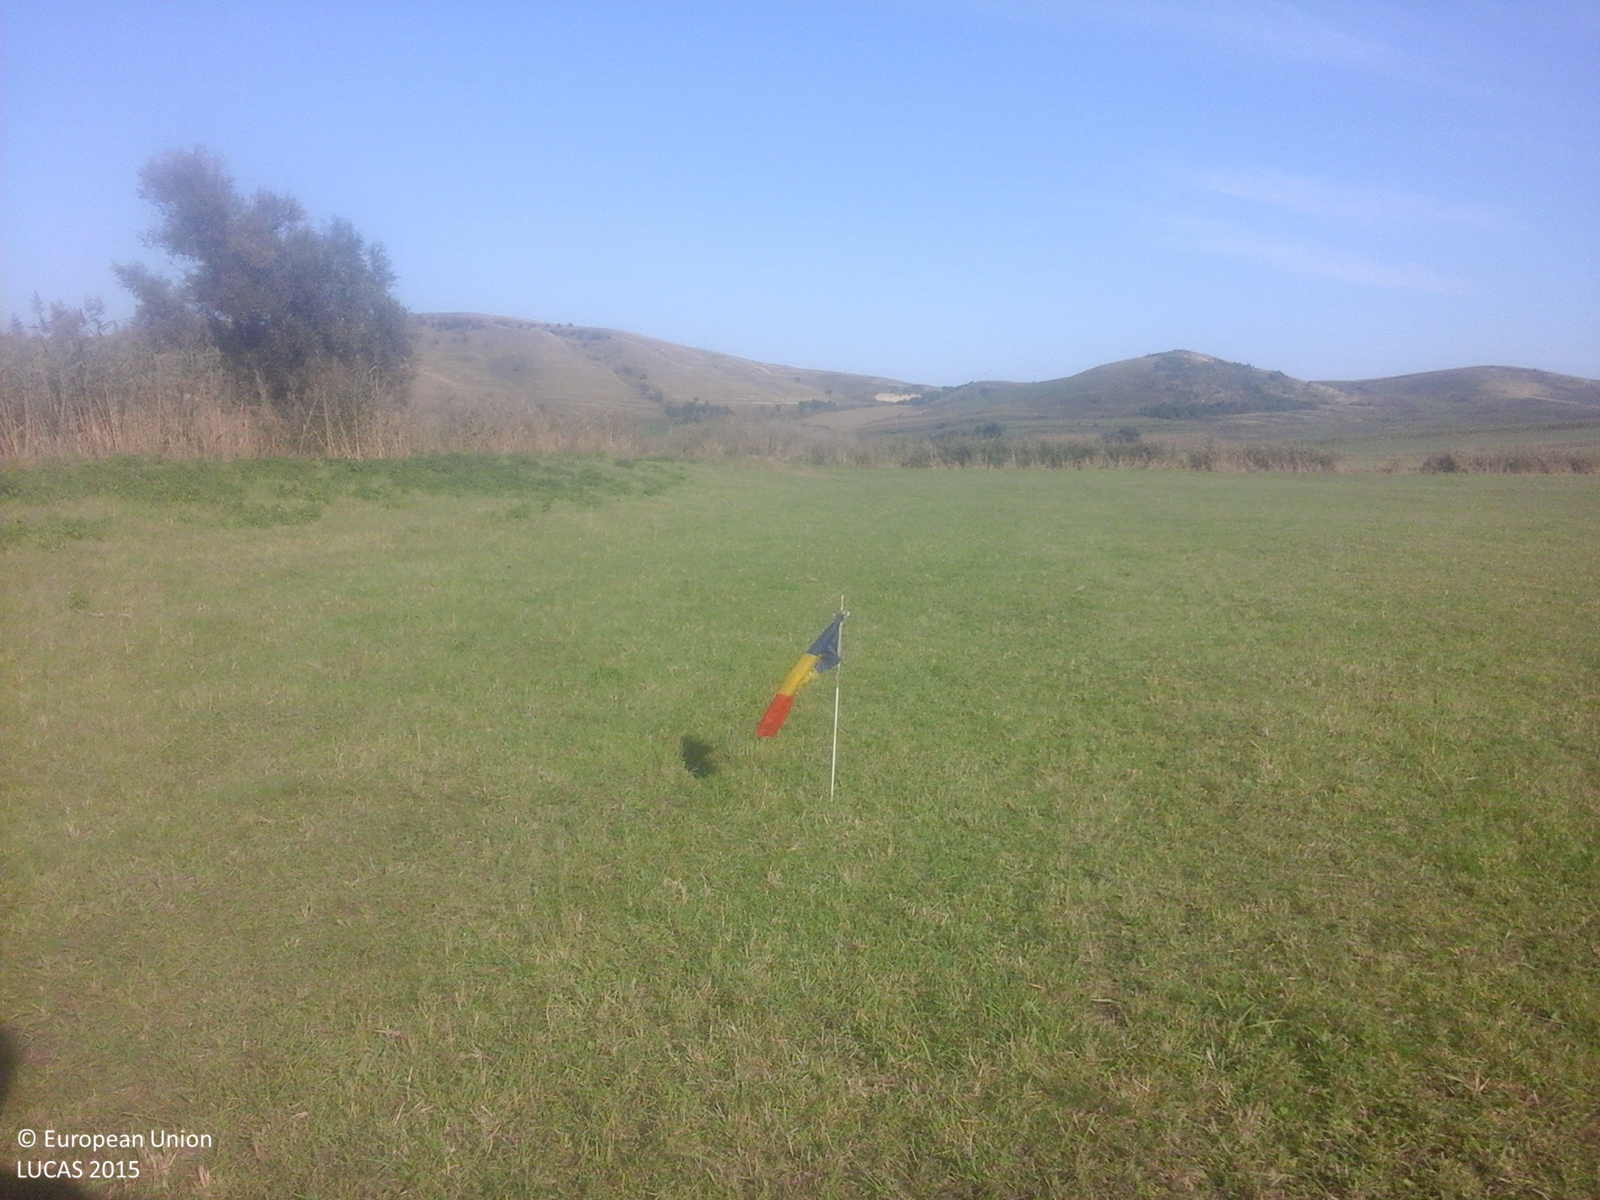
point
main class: Grassland
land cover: Grassland without tree/shrub cover
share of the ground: > 75 %
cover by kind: herbaceous plants 100 %
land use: Agriculture (excluding fallow land and kitchen gardens)
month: October
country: RO
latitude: 45.9311
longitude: 24.0406
